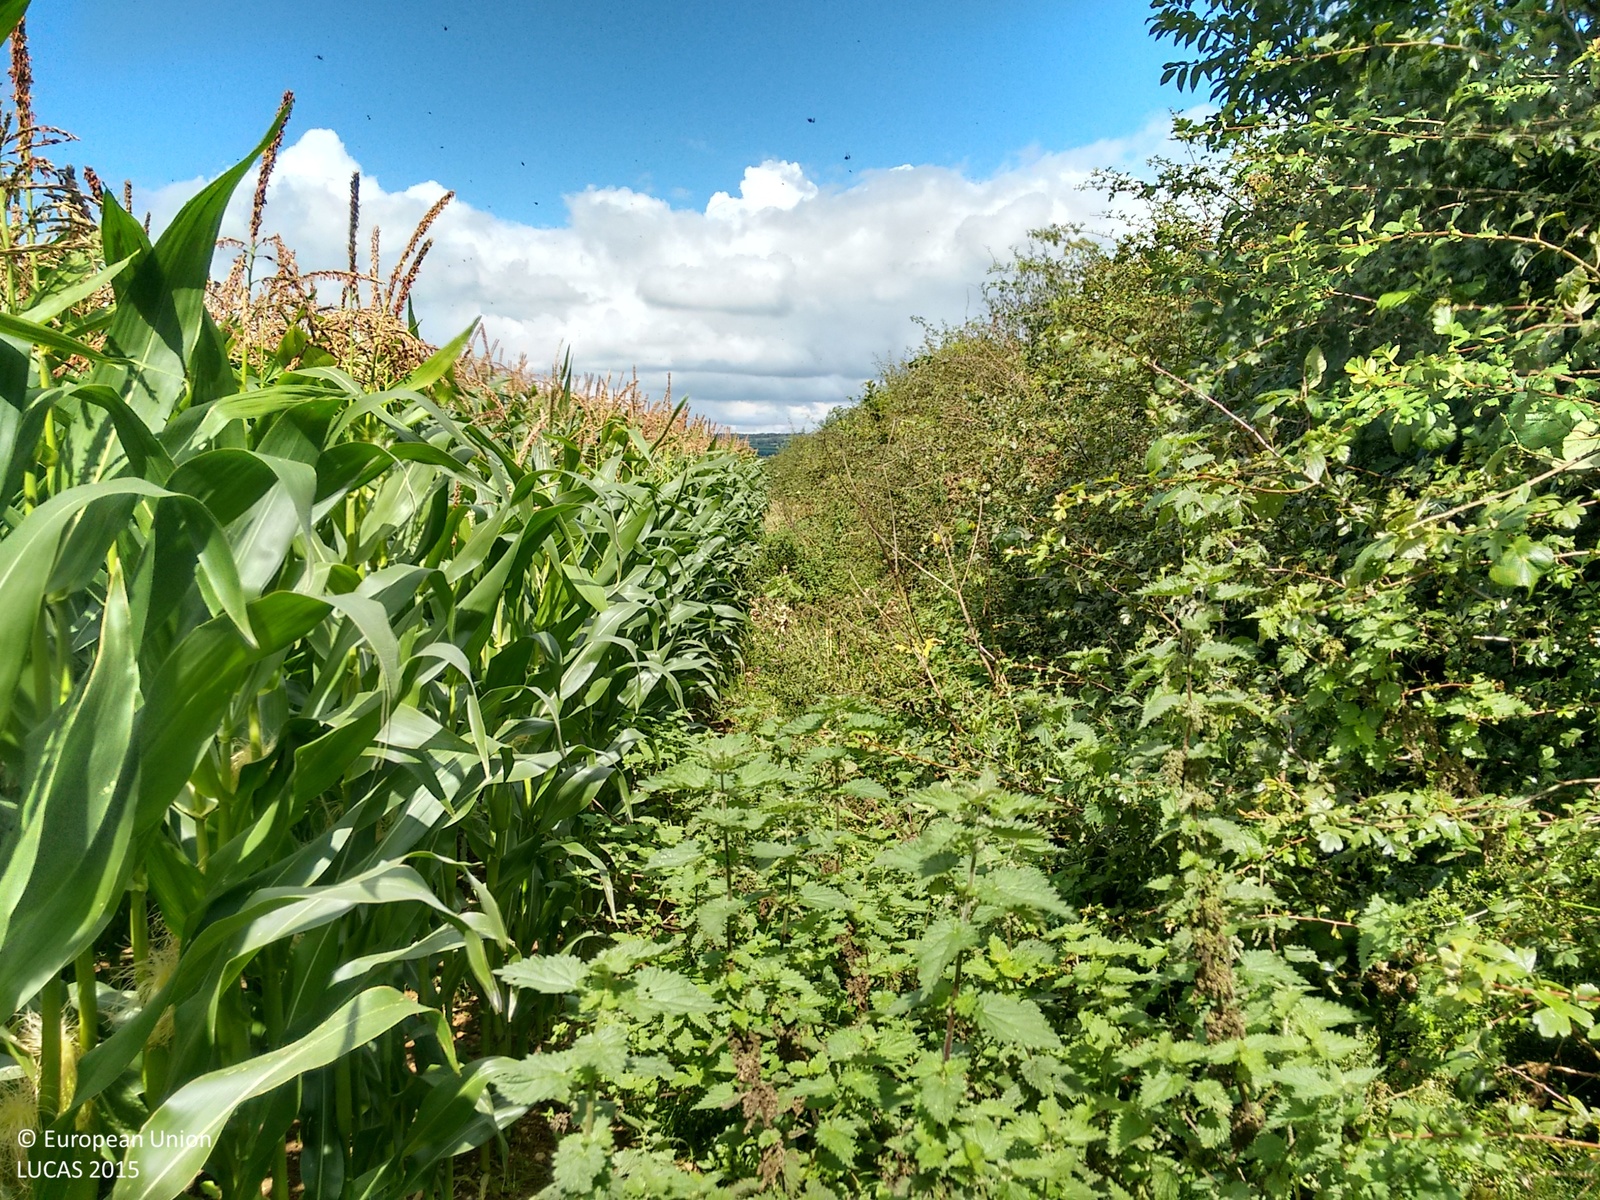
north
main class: Cropland
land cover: Maize
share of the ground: > 75 %
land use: Agriculture (excluding fallow land and kitchen gardens)
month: September
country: GB
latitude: 50.5502
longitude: -4.1971
